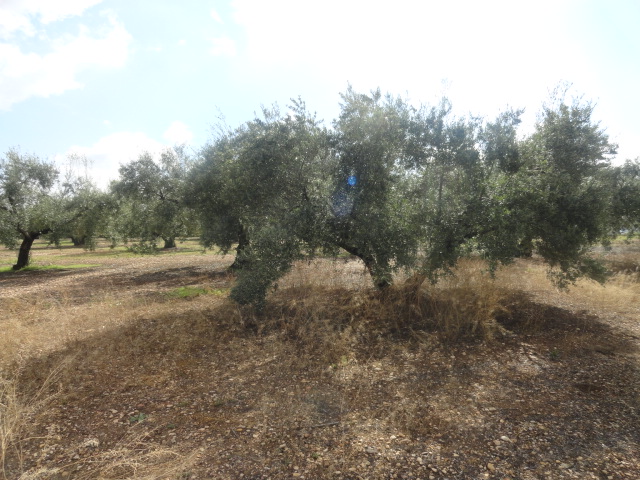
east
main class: Cropland
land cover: Olive groves
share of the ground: 50 - 75 %
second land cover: Spontaneously vegetated surfaces
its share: 10 - 25 %
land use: Agriculture (excluding fallow land and kitchen gardens)
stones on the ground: > 50 %
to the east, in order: Olive groves; Spontaneously vegetated surfaces; Electric lines; Olive groves; Tracks; Olive groves
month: April
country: ES
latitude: 37.6093
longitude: -4.5865
